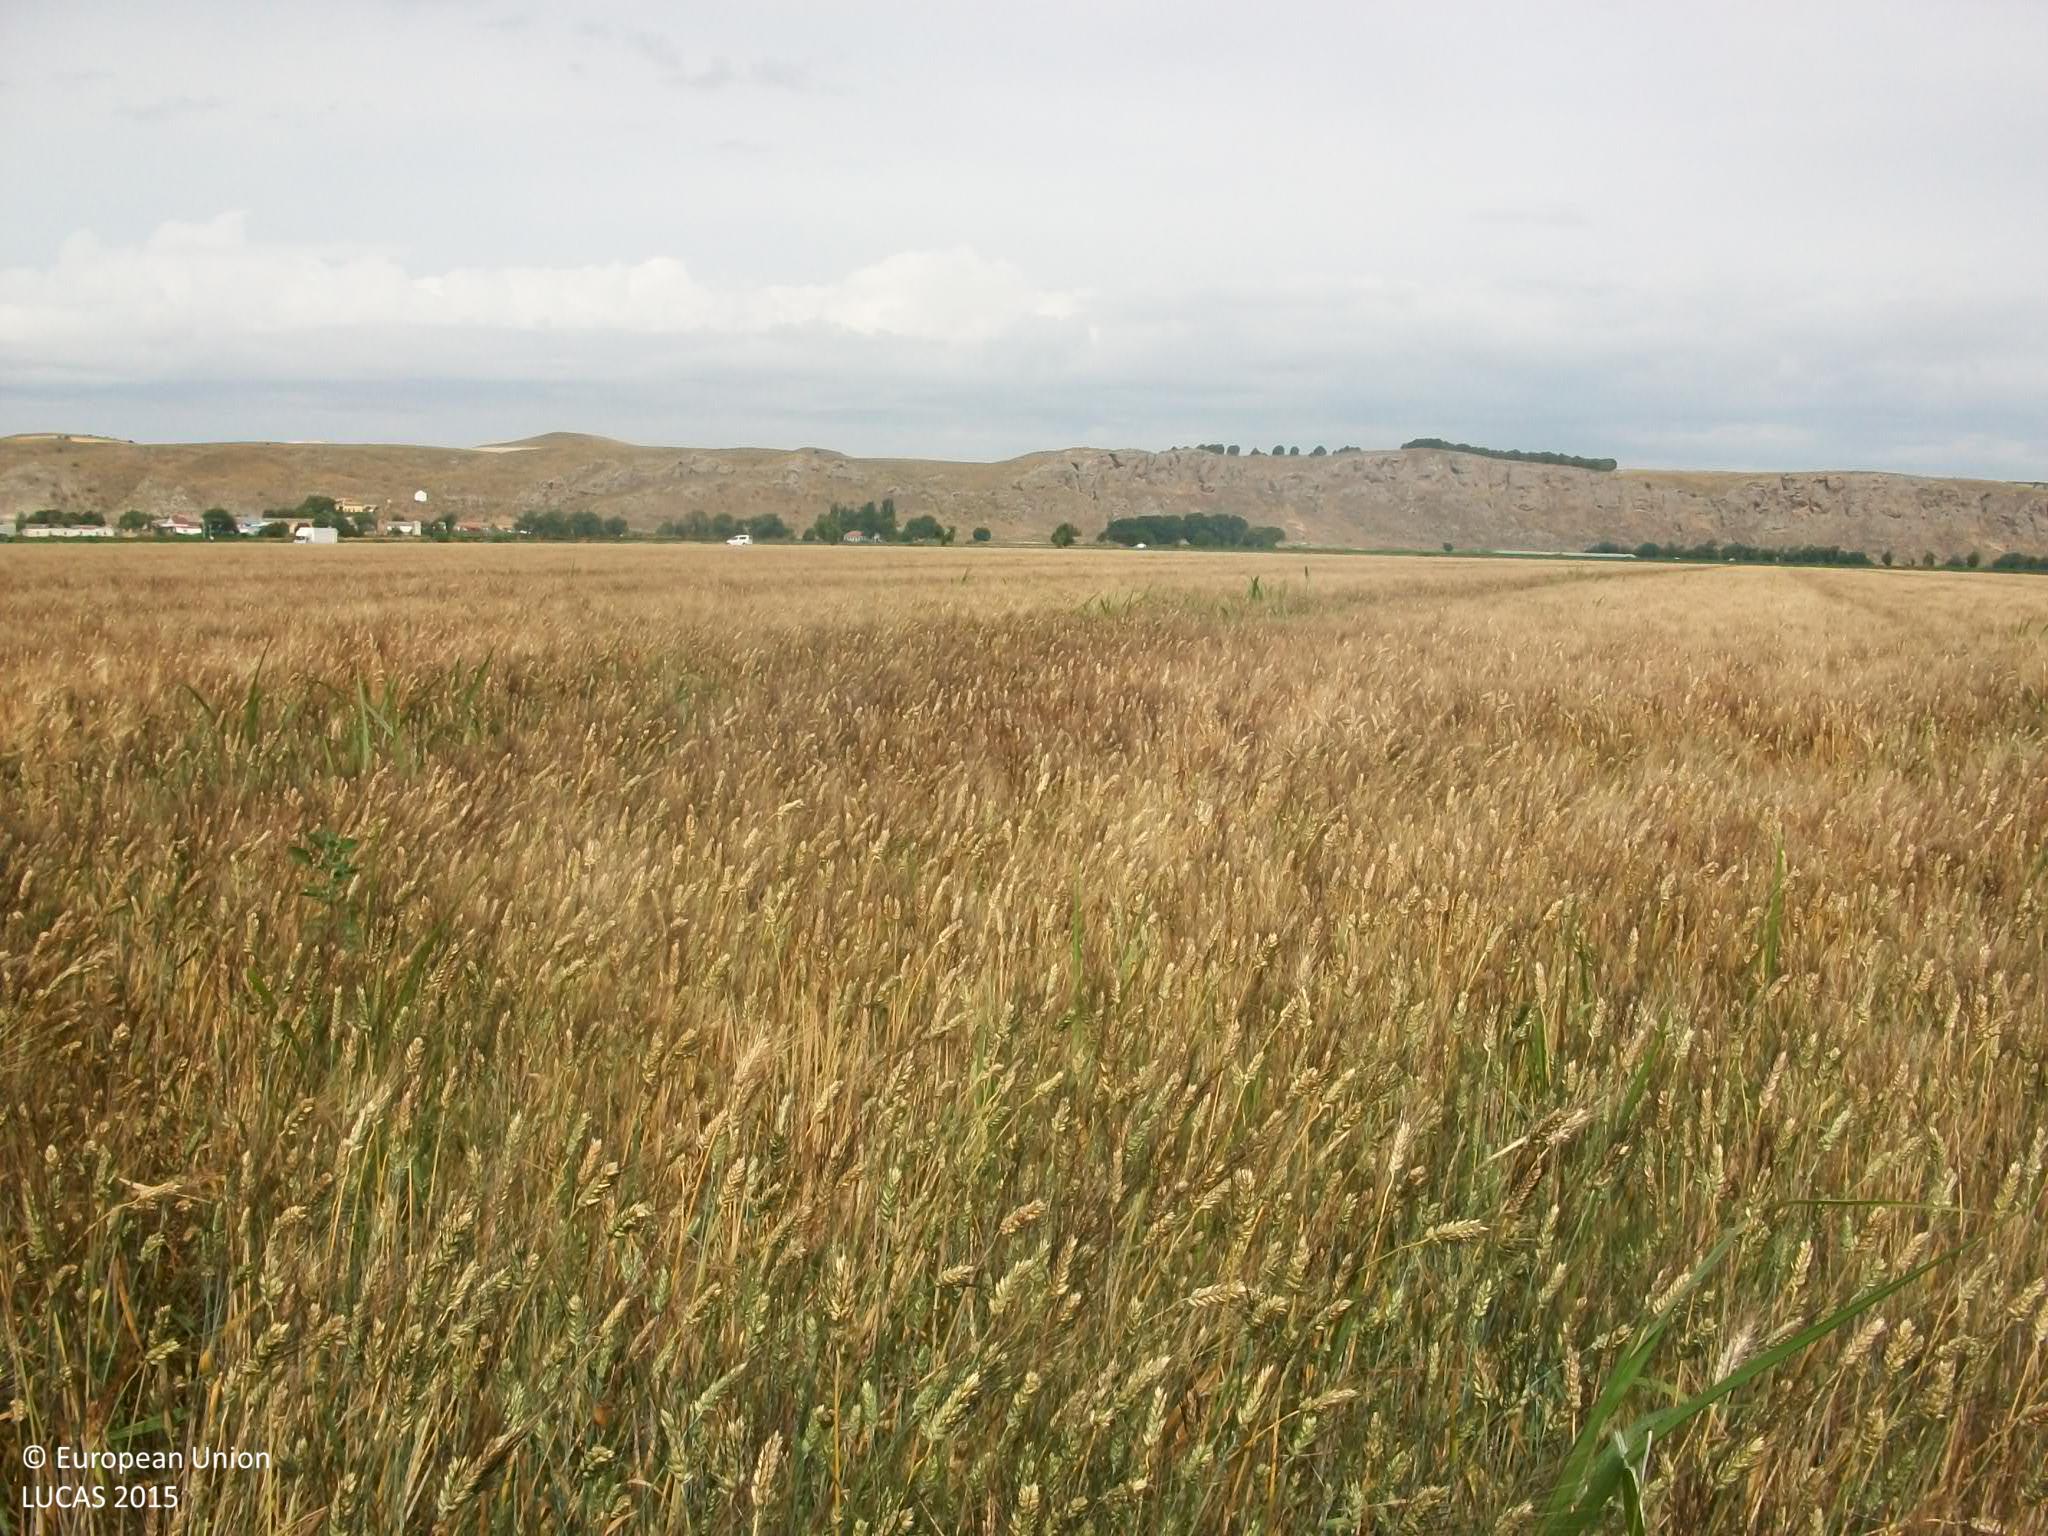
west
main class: Cropland
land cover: Common wheat
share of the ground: > 75 %
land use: Agriculture (excluding fallow land and kitchen gardens)
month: June
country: ES
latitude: 40.2576
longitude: -3.5428
